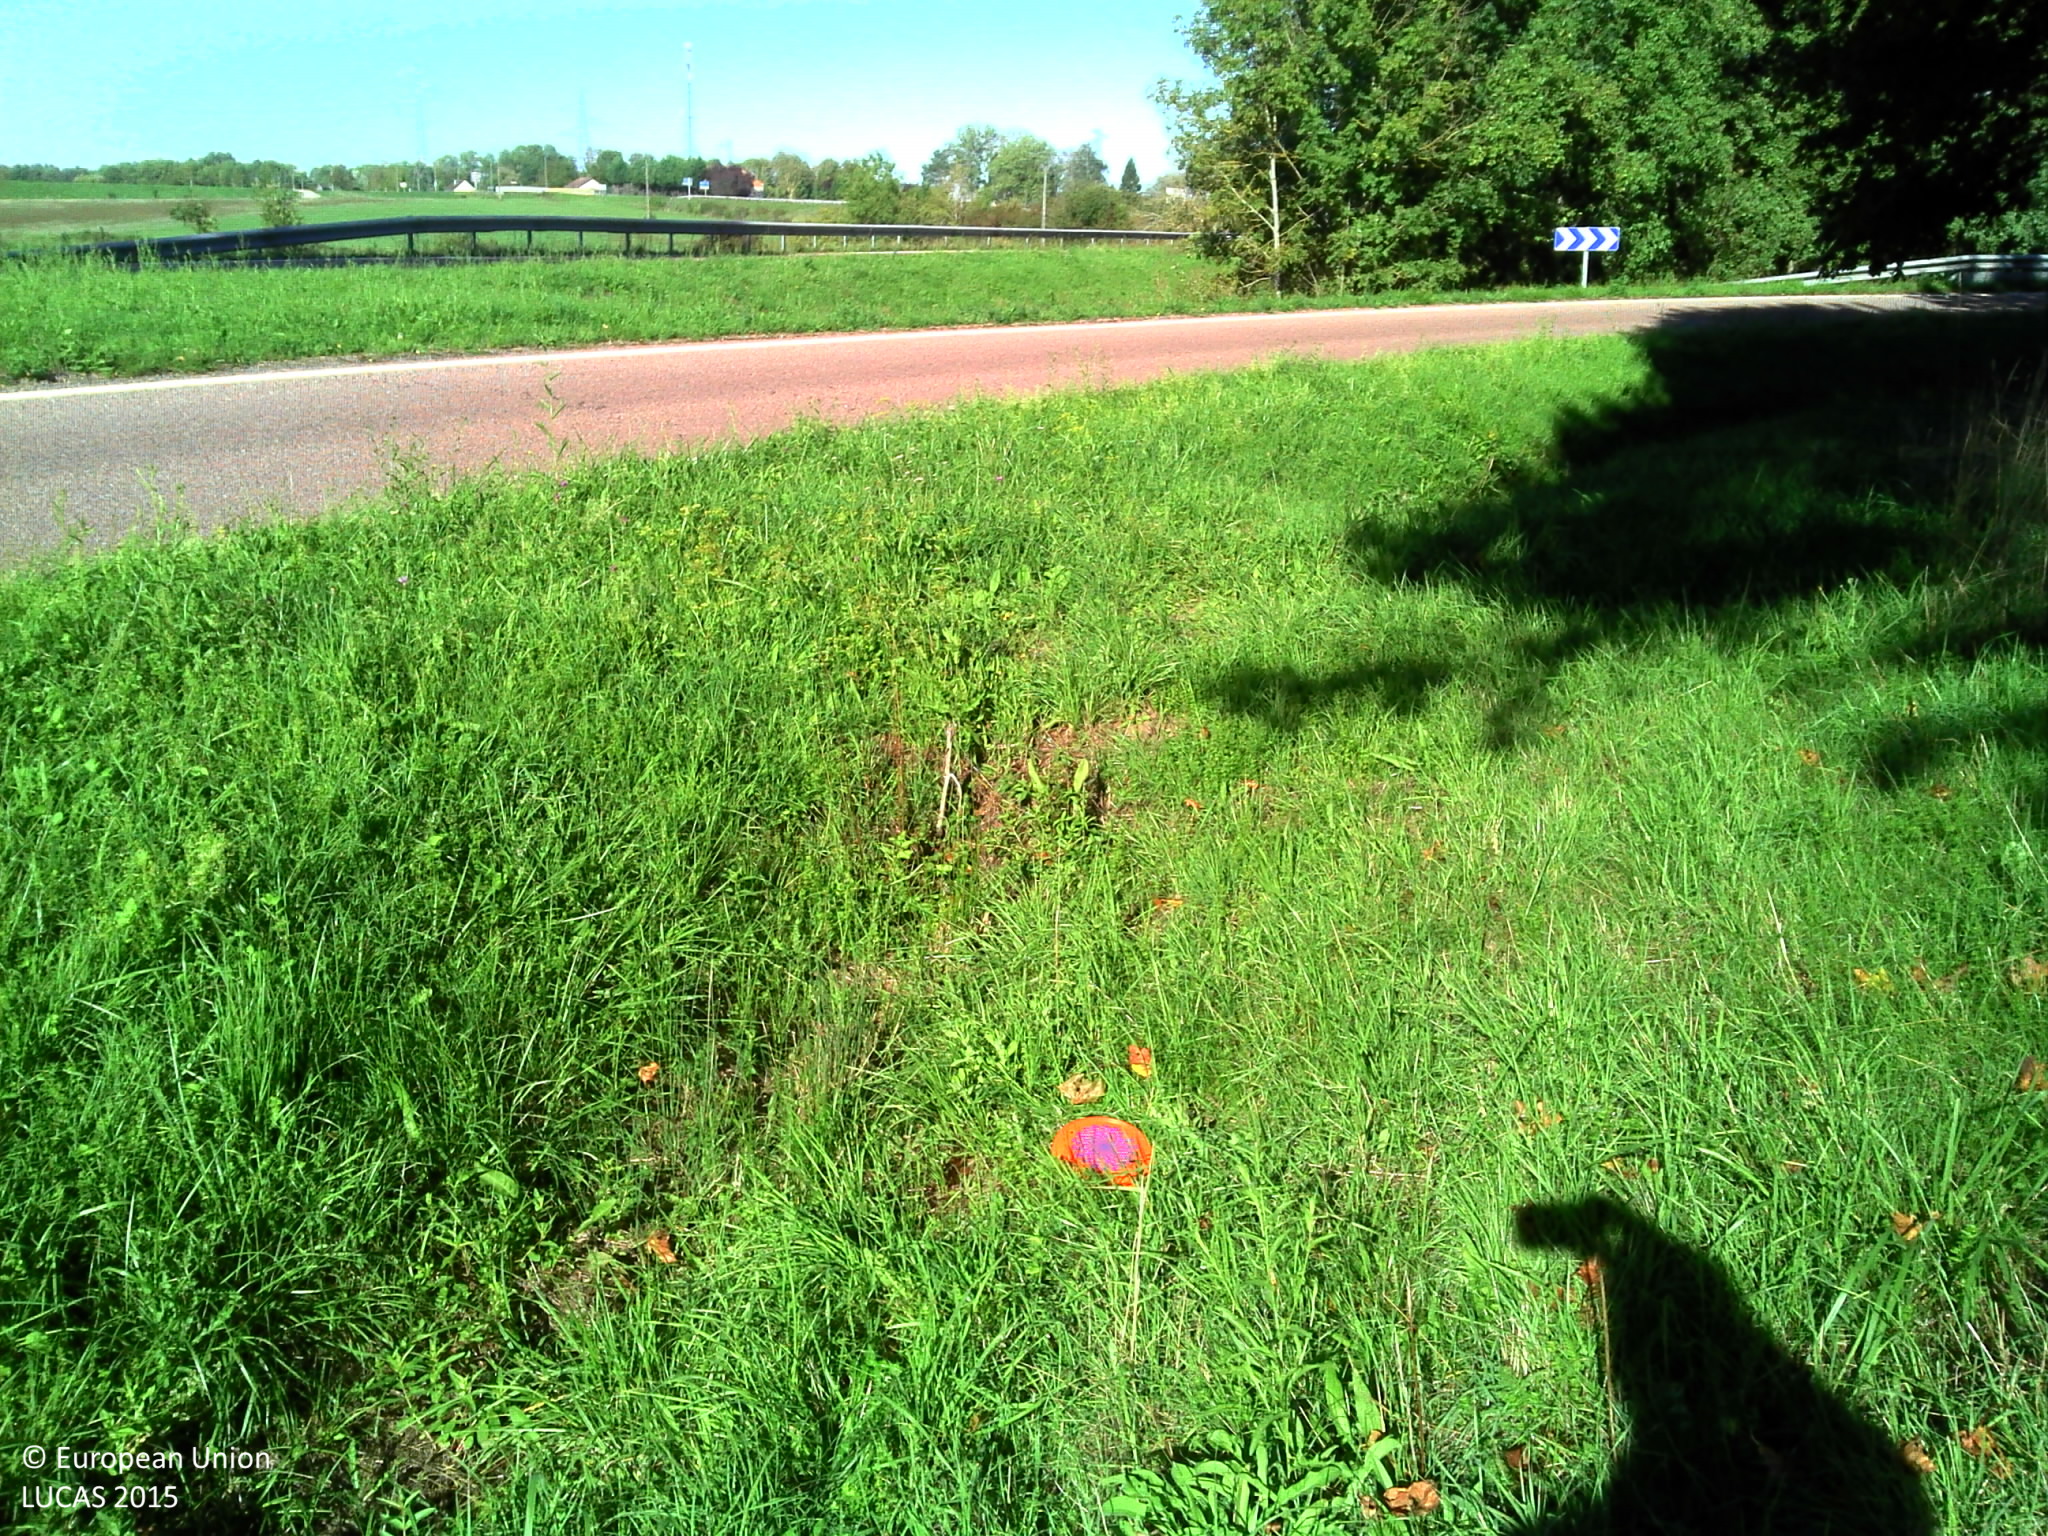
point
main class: Woodland
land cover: Broadleaved woodland
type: mesophytic deciduous forest
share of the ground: > 75 %
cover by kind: broadleaved forest trees 70 %, herbaceous plants 30 %
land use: Semi-natural and natural areas not in use
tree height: > 5 m
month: September
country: FR
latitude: 48.2399
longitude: 4.3284
